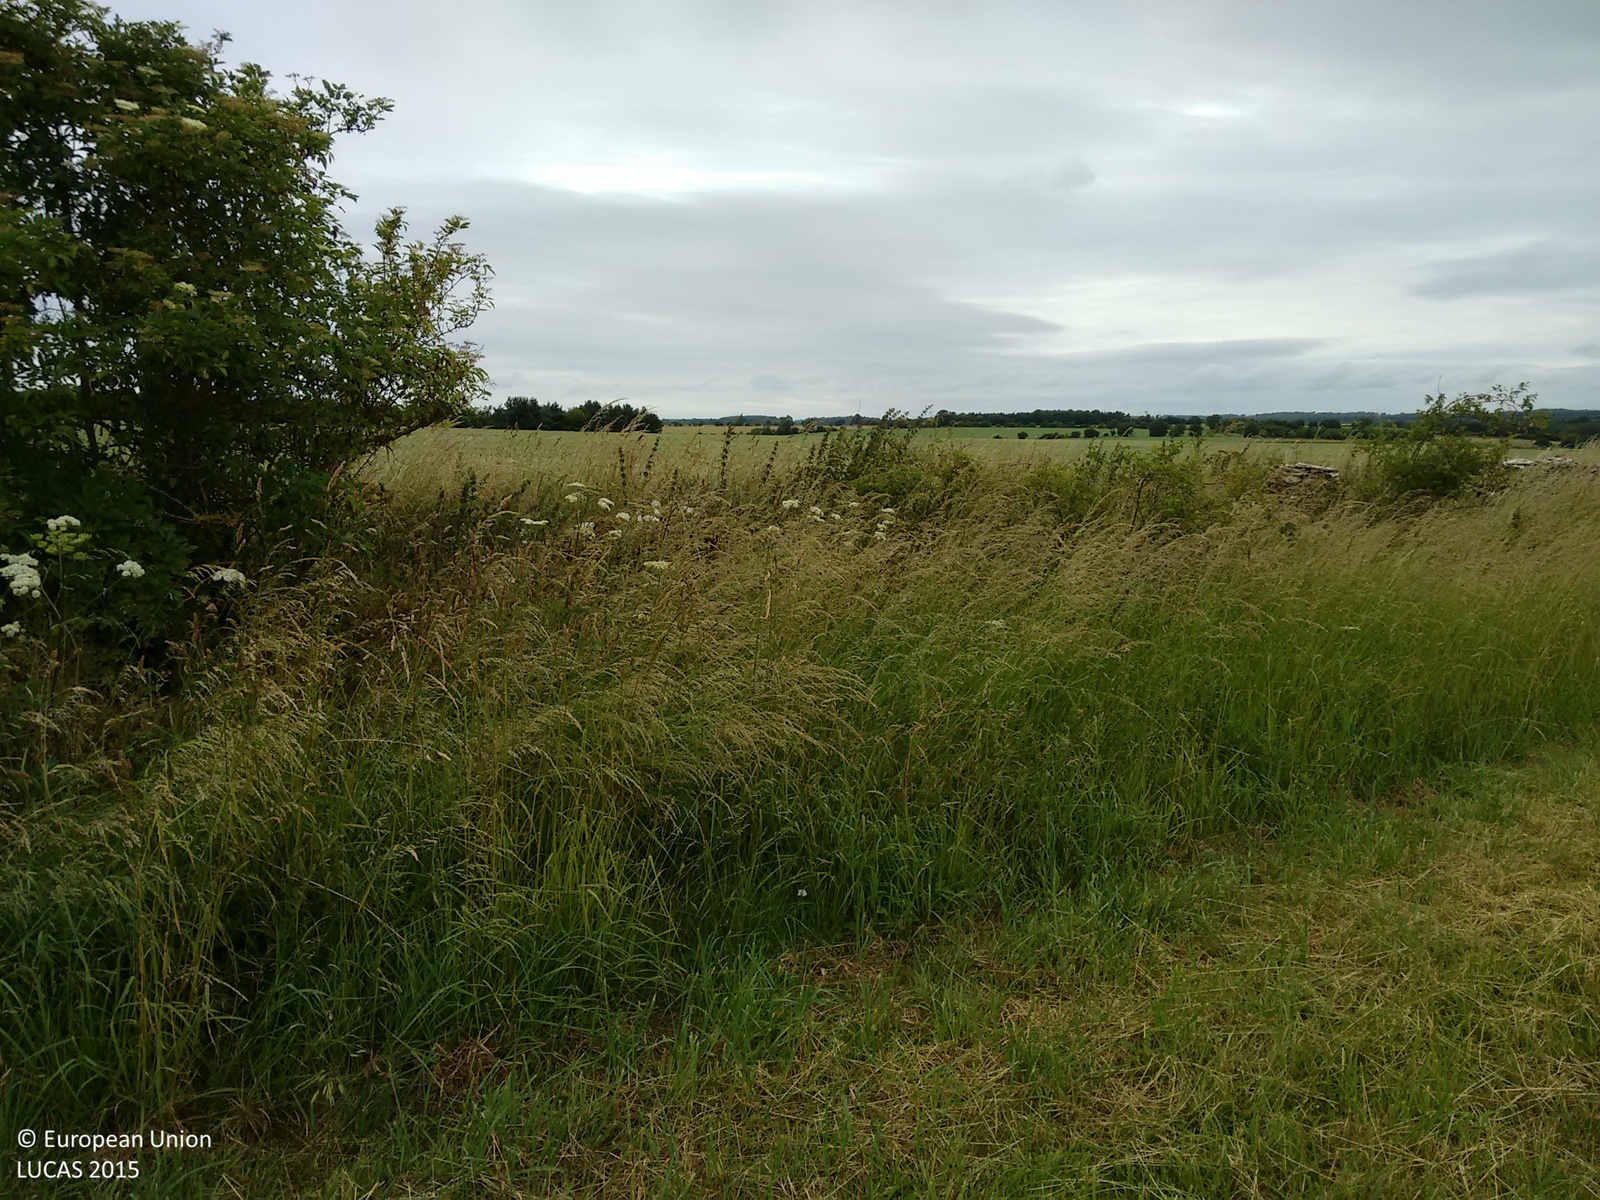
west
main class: Cropland
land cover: Barley
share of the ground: > 75 %
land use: Agriculture (excluding fallow land and kitchen gardens)
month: July
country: GB
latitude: 51.7848
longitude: -1.6356
